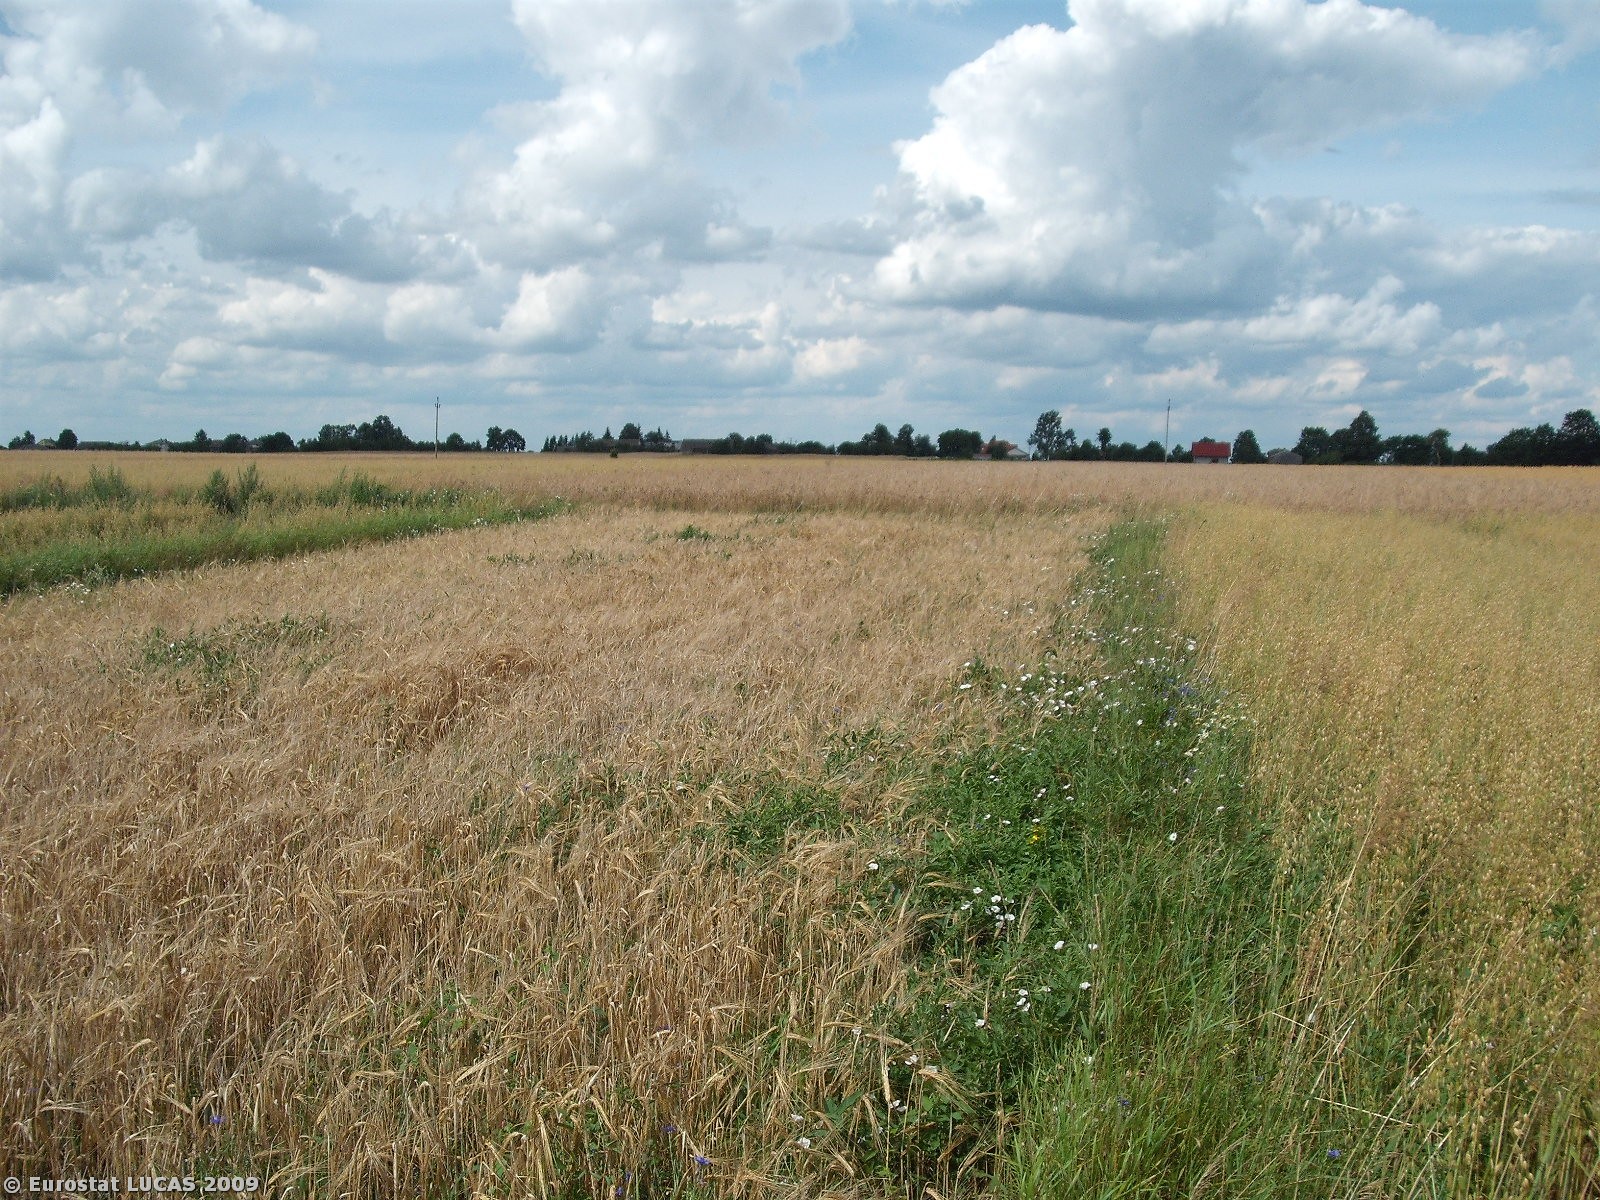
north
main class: Cropland
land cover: Oats
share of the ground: > 75 %
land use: Agriculture (excluding fallow land and kitchen gardens)
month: July
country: PL
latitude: 51.1050
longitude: 21.3461
